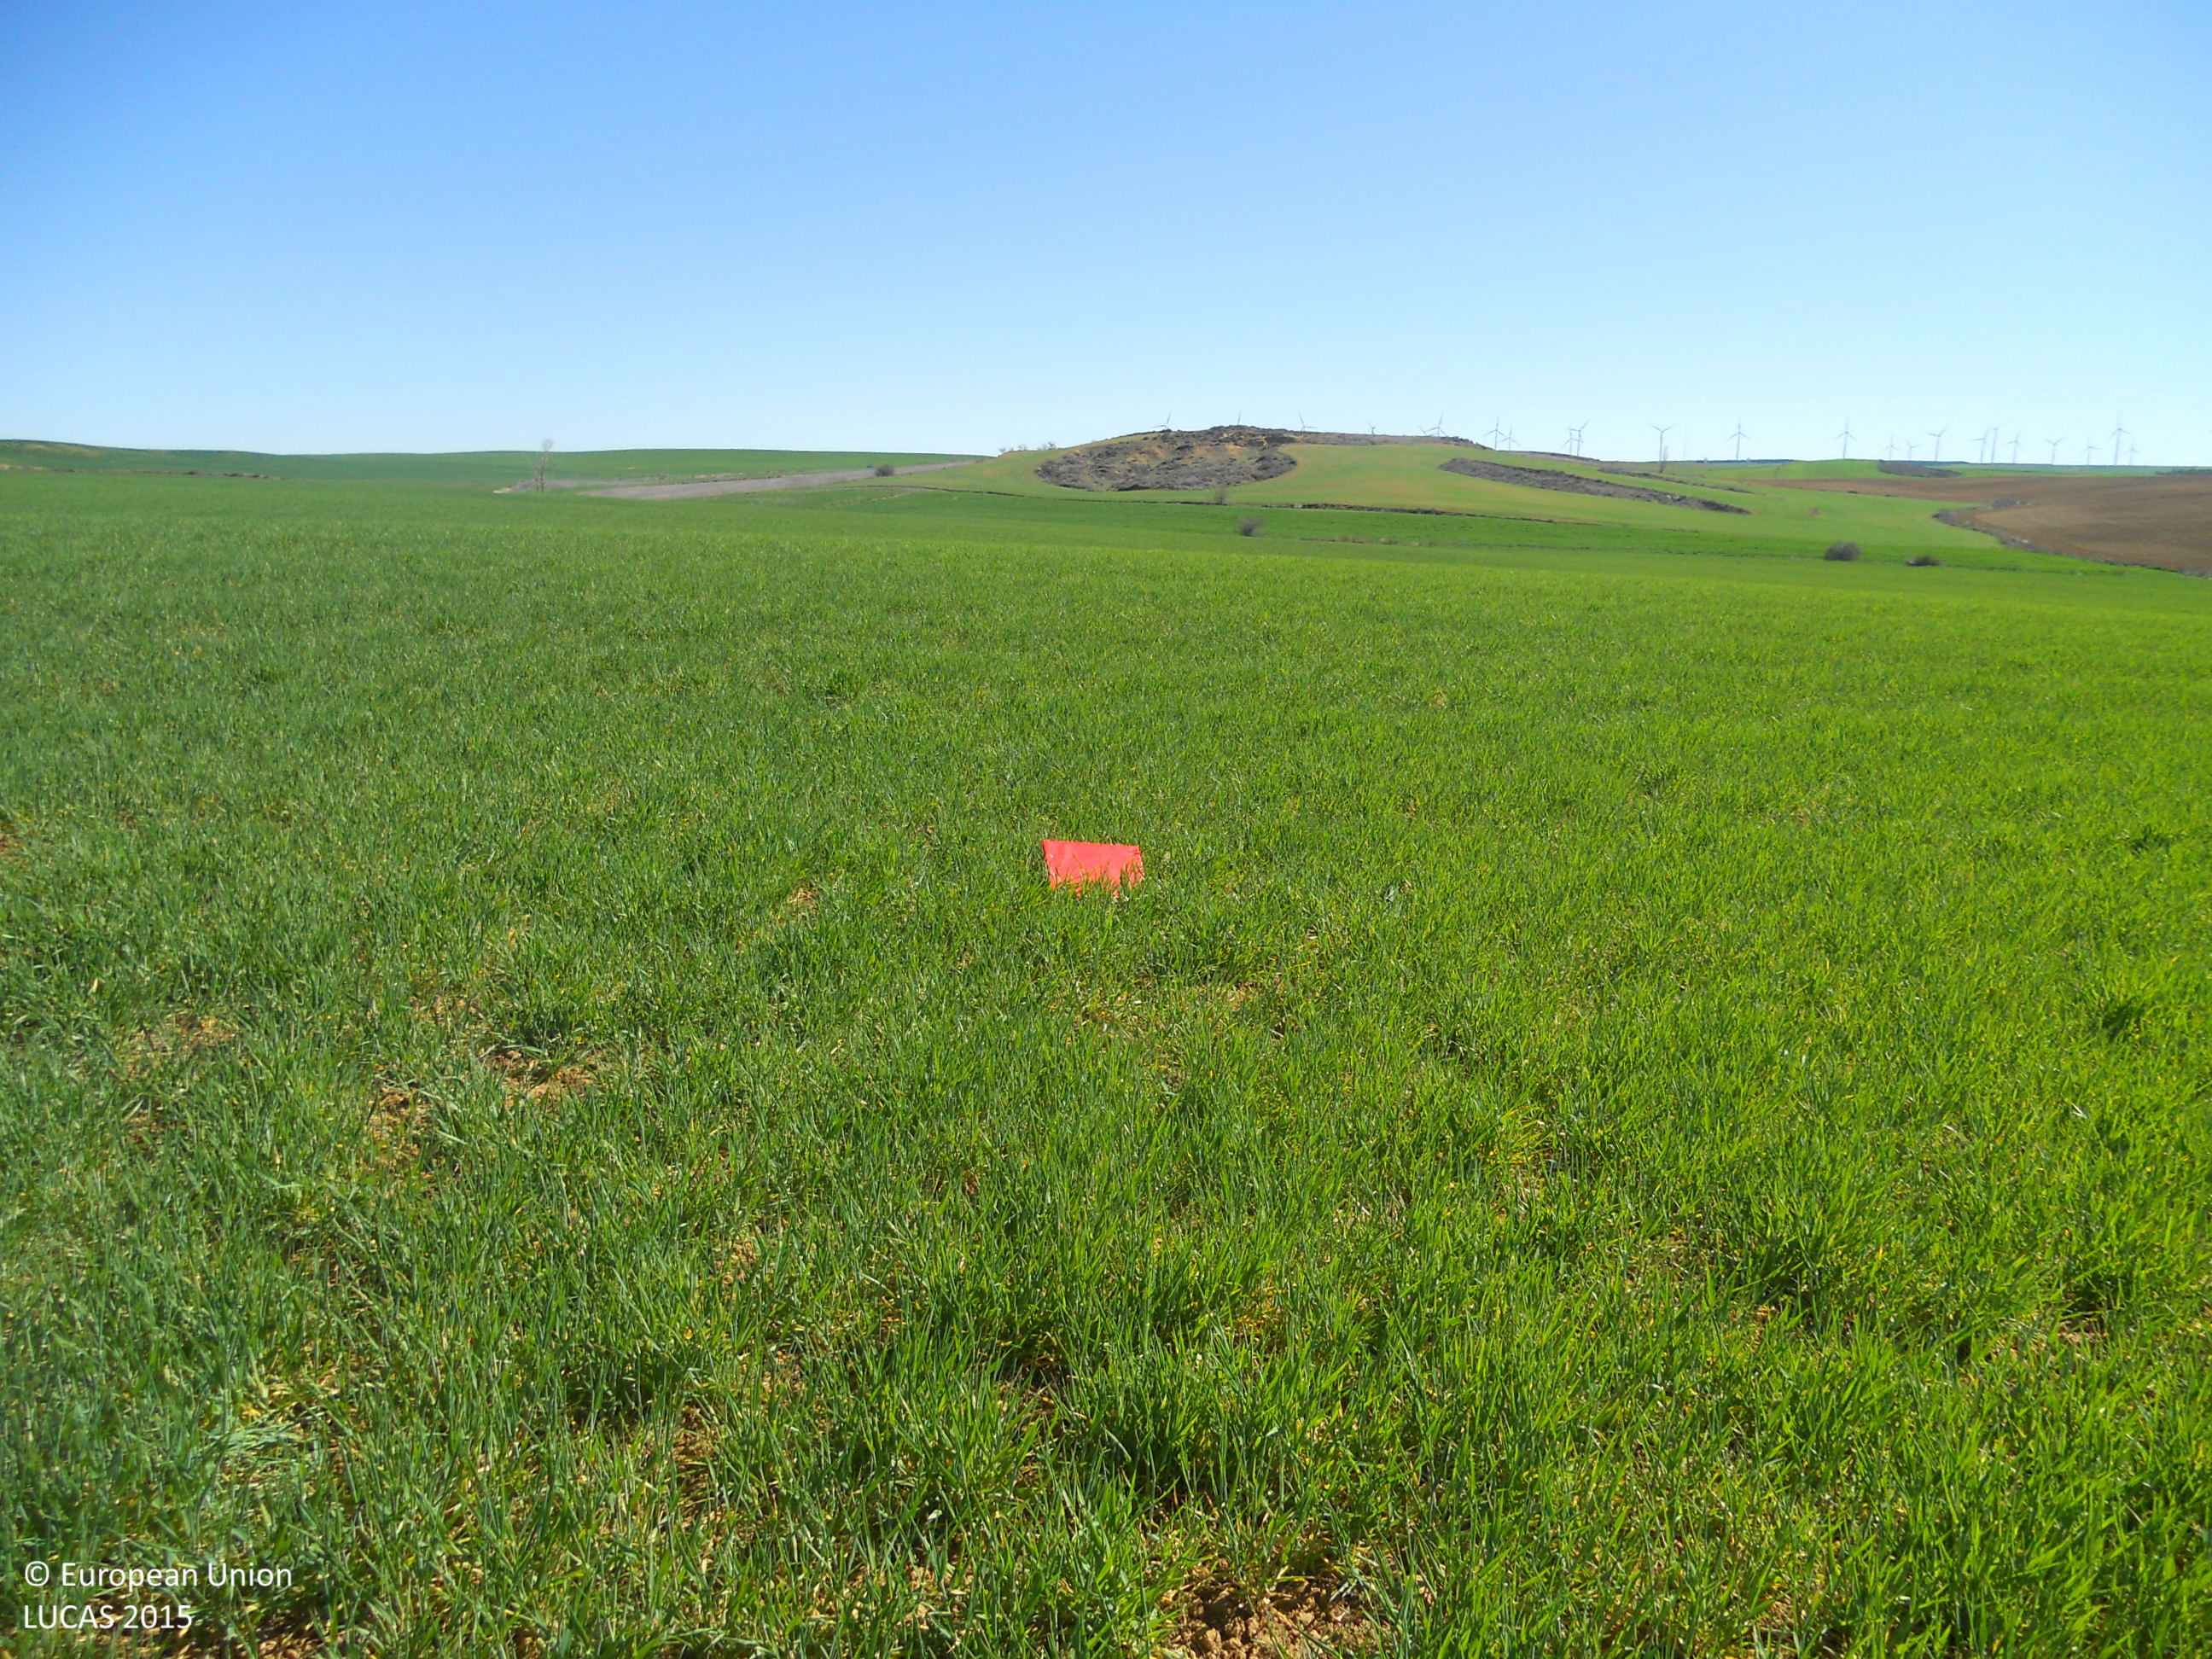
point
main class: Cropland
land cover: Barley
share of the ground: > 75 %
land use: Agriculture (excluding fallow land and kitchen gardens)
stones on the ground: < 10 %
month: April
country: ES
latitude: 42.2414
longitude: -4.7773
